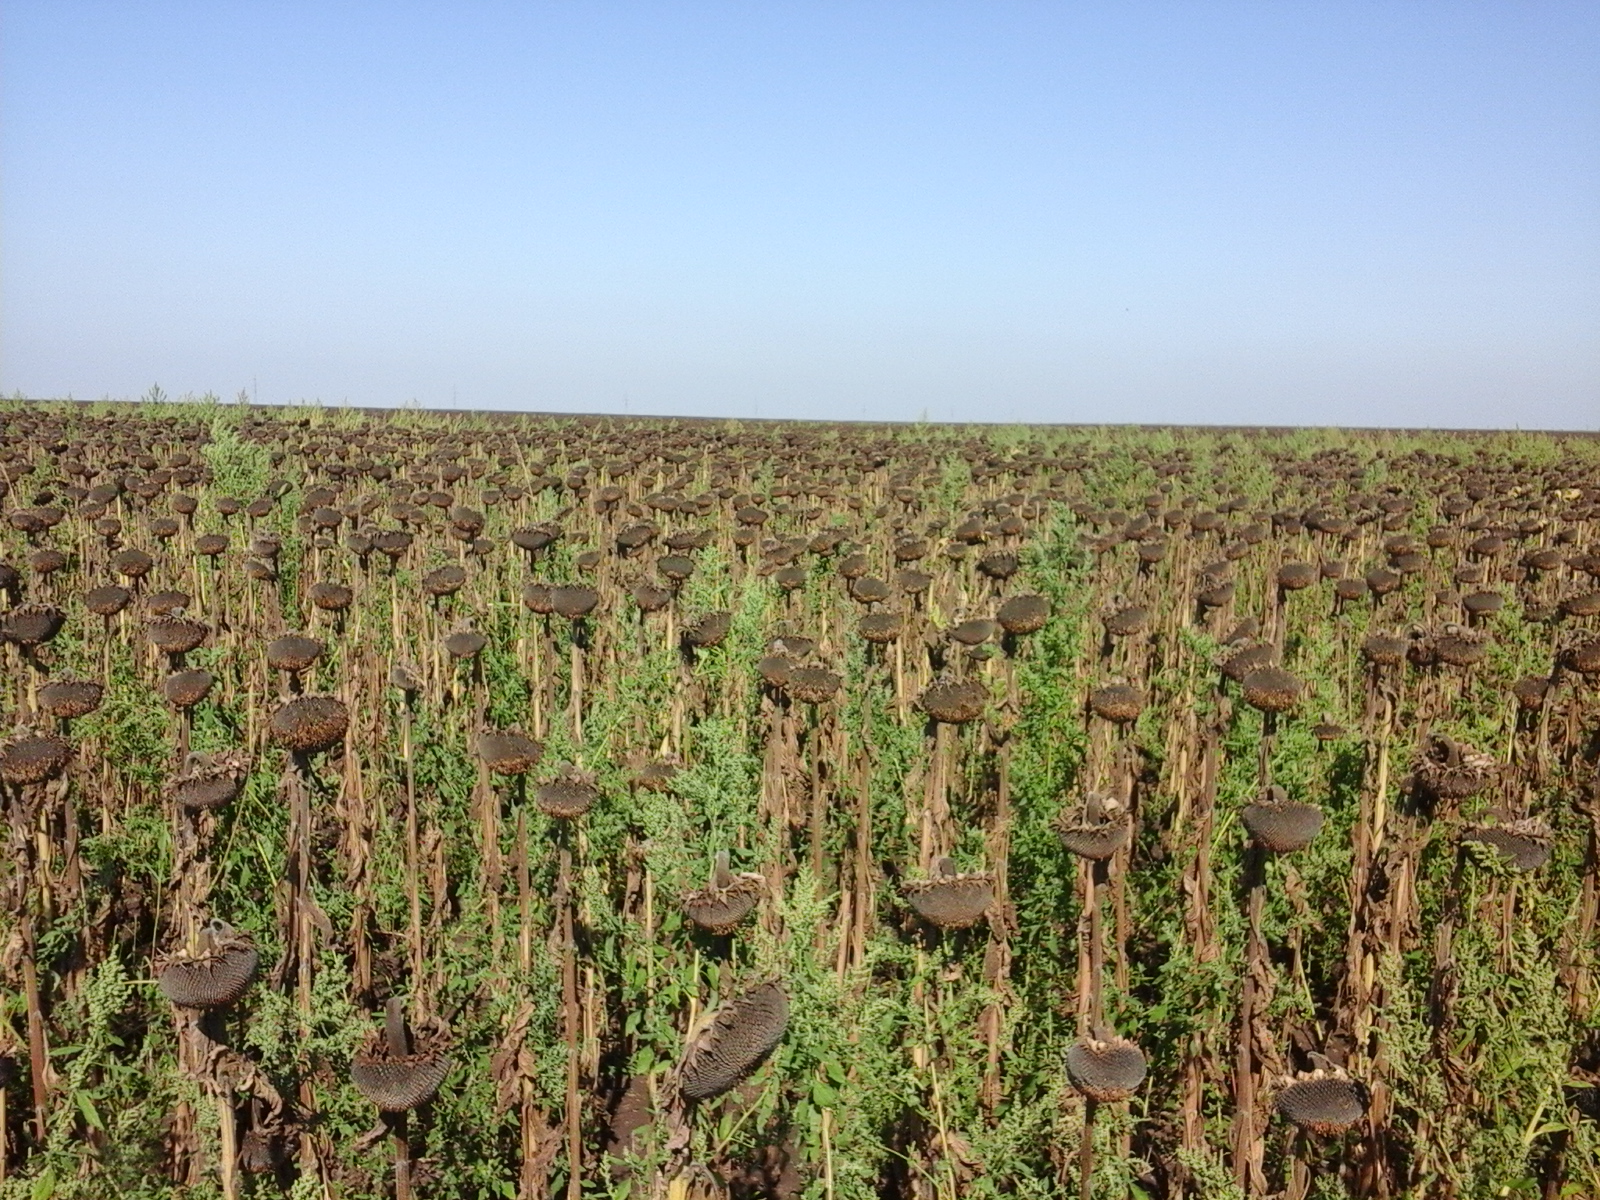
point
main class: Cropland
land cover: Sunflower
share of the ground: > 75 %
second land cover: Spontaneously vegetated surfaces
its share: 50 - 75 %
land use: Agriculture (excluding fallow land and kitchen gardens)
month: August
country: RO
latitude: 45.9013
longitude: 21.0760
